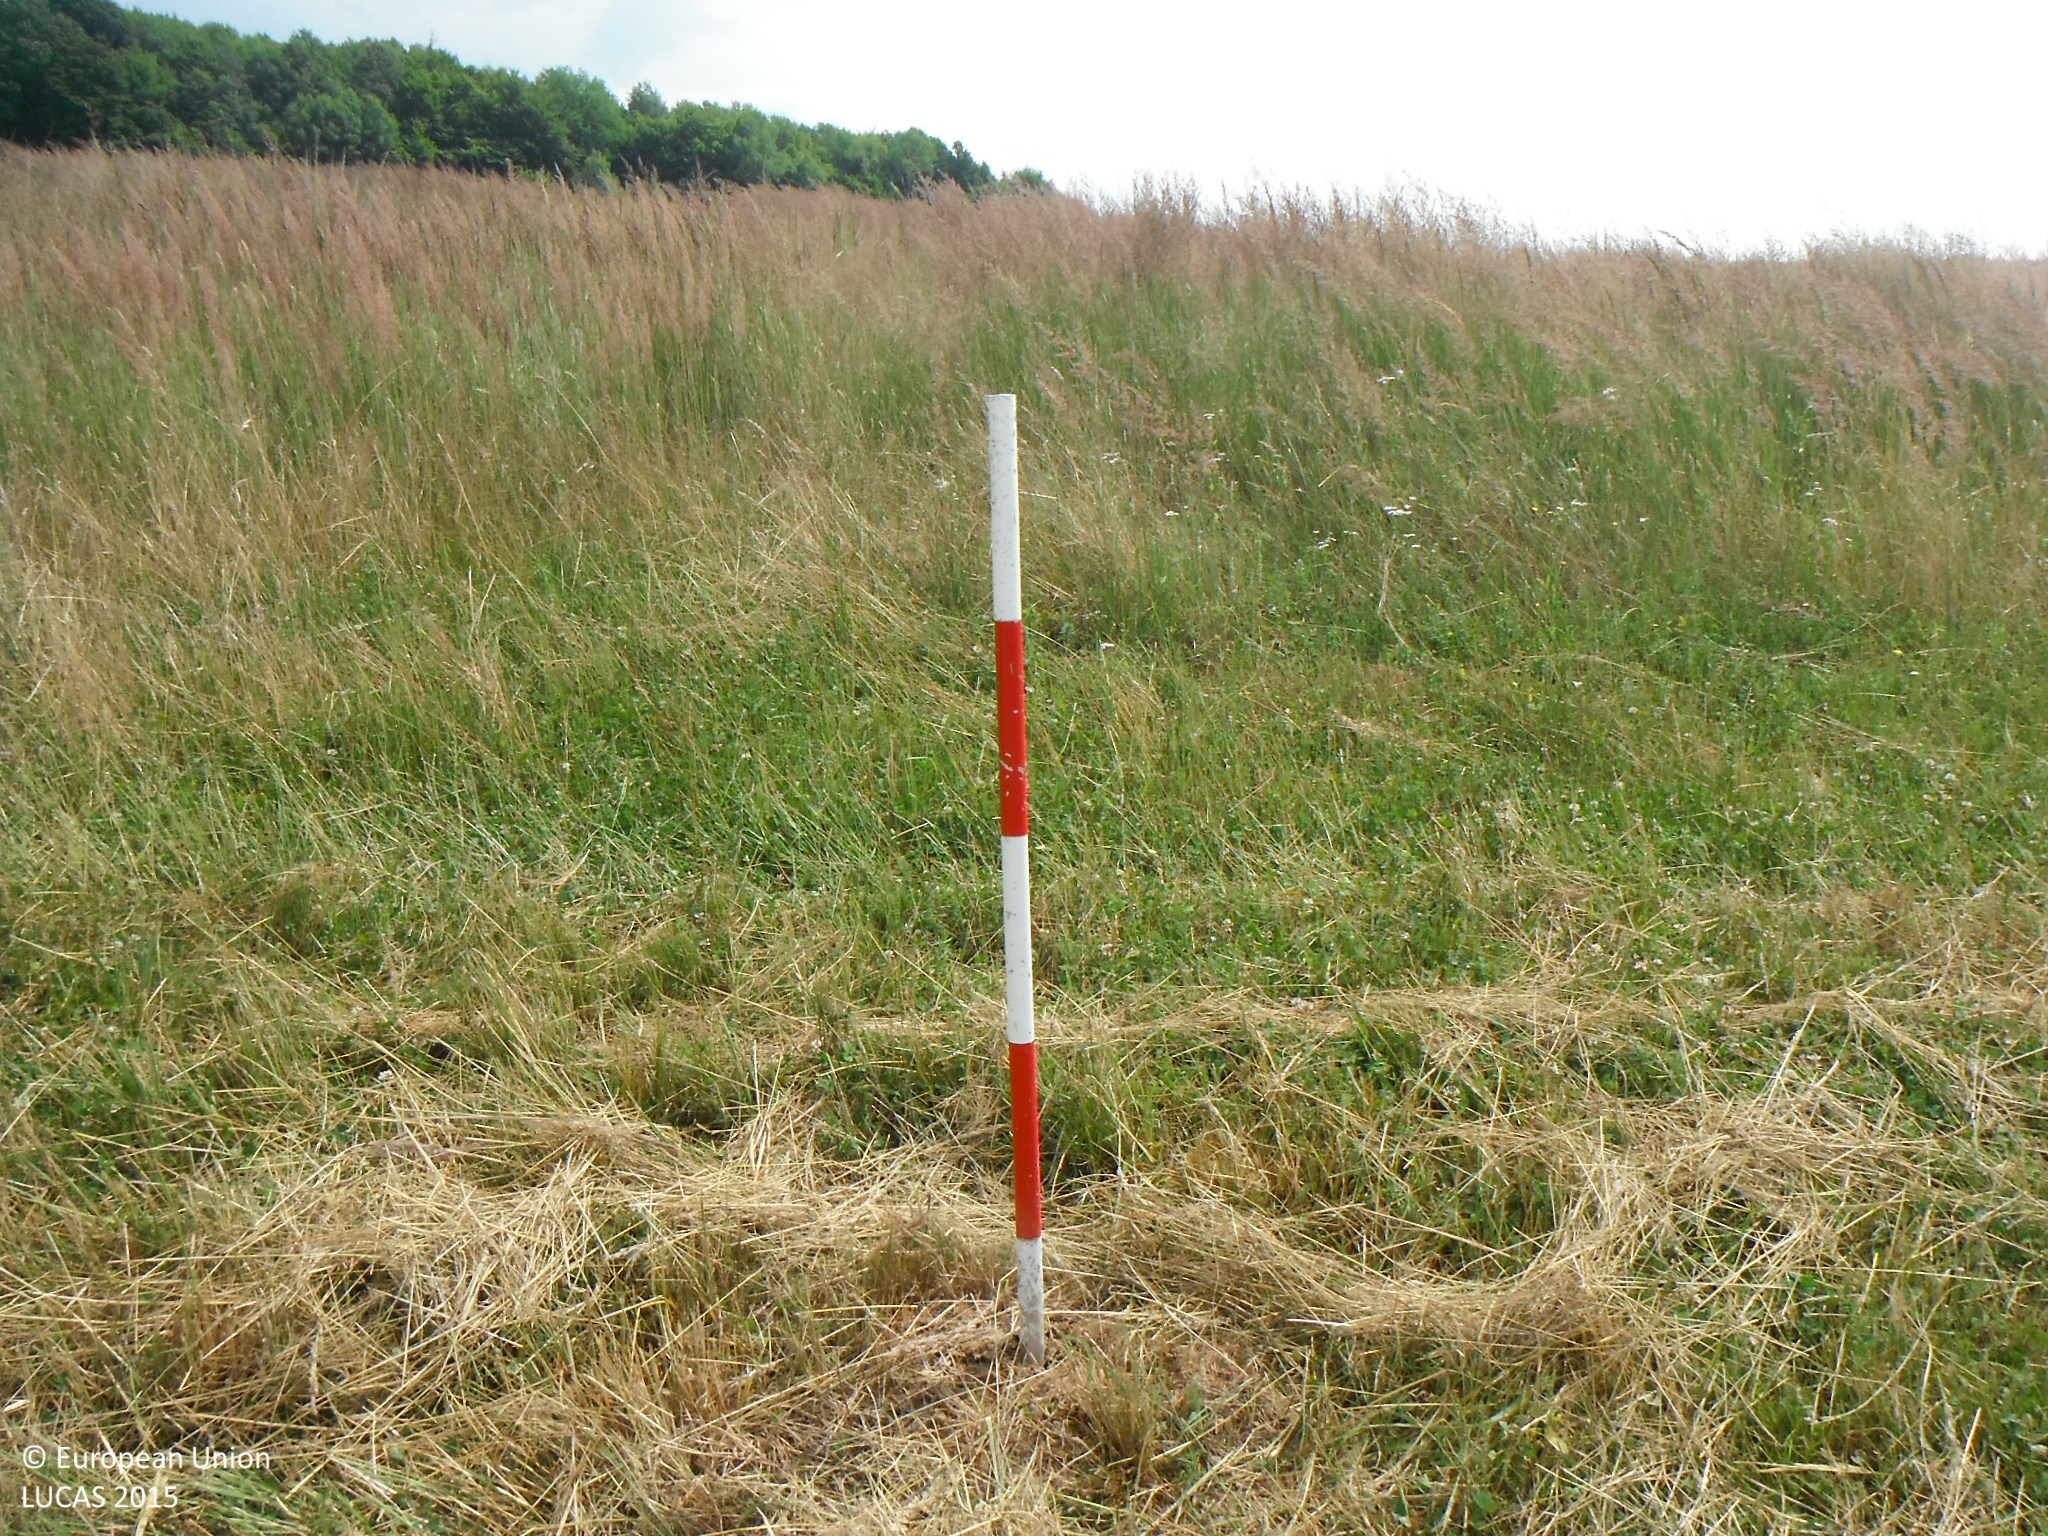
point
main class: Grassland
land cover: Grassland without tree/shrub cover
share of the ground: > 75 %
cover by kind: herbaceous plants 100 %
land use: Agriculture (excluding fallow land and kitchen gardens)
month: June
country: SK
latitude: 48.5178
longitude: 19.9255
